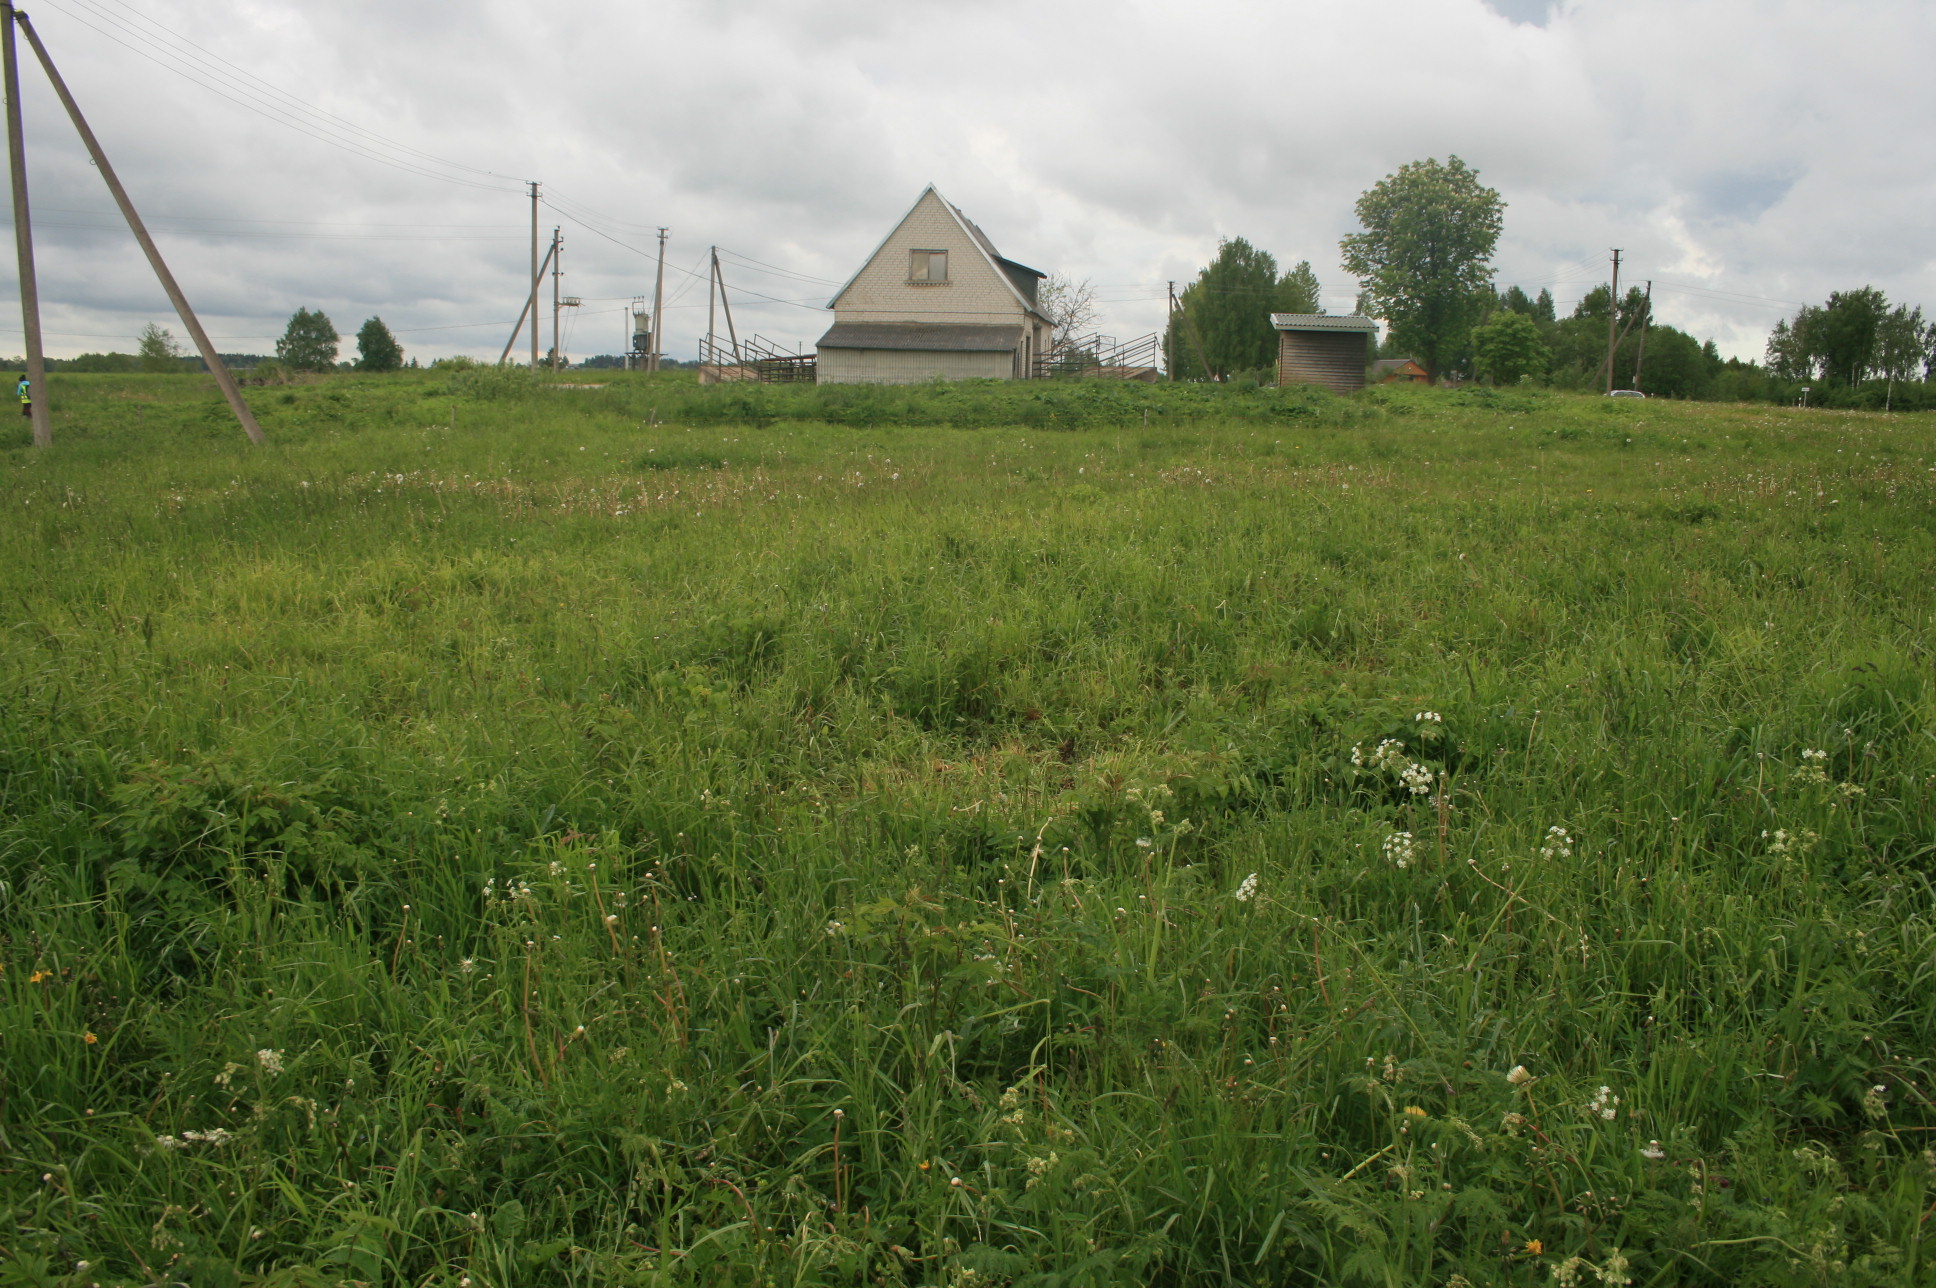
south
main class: Grassland
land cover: Grassland without tree/shrub cover
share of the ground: > 75 %
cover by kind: herbaceous plants 100 %
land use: Agriculture (excluding fallow land and kitchen gardens)
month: May
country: LT
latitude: 55.9250
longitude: 21.8765
